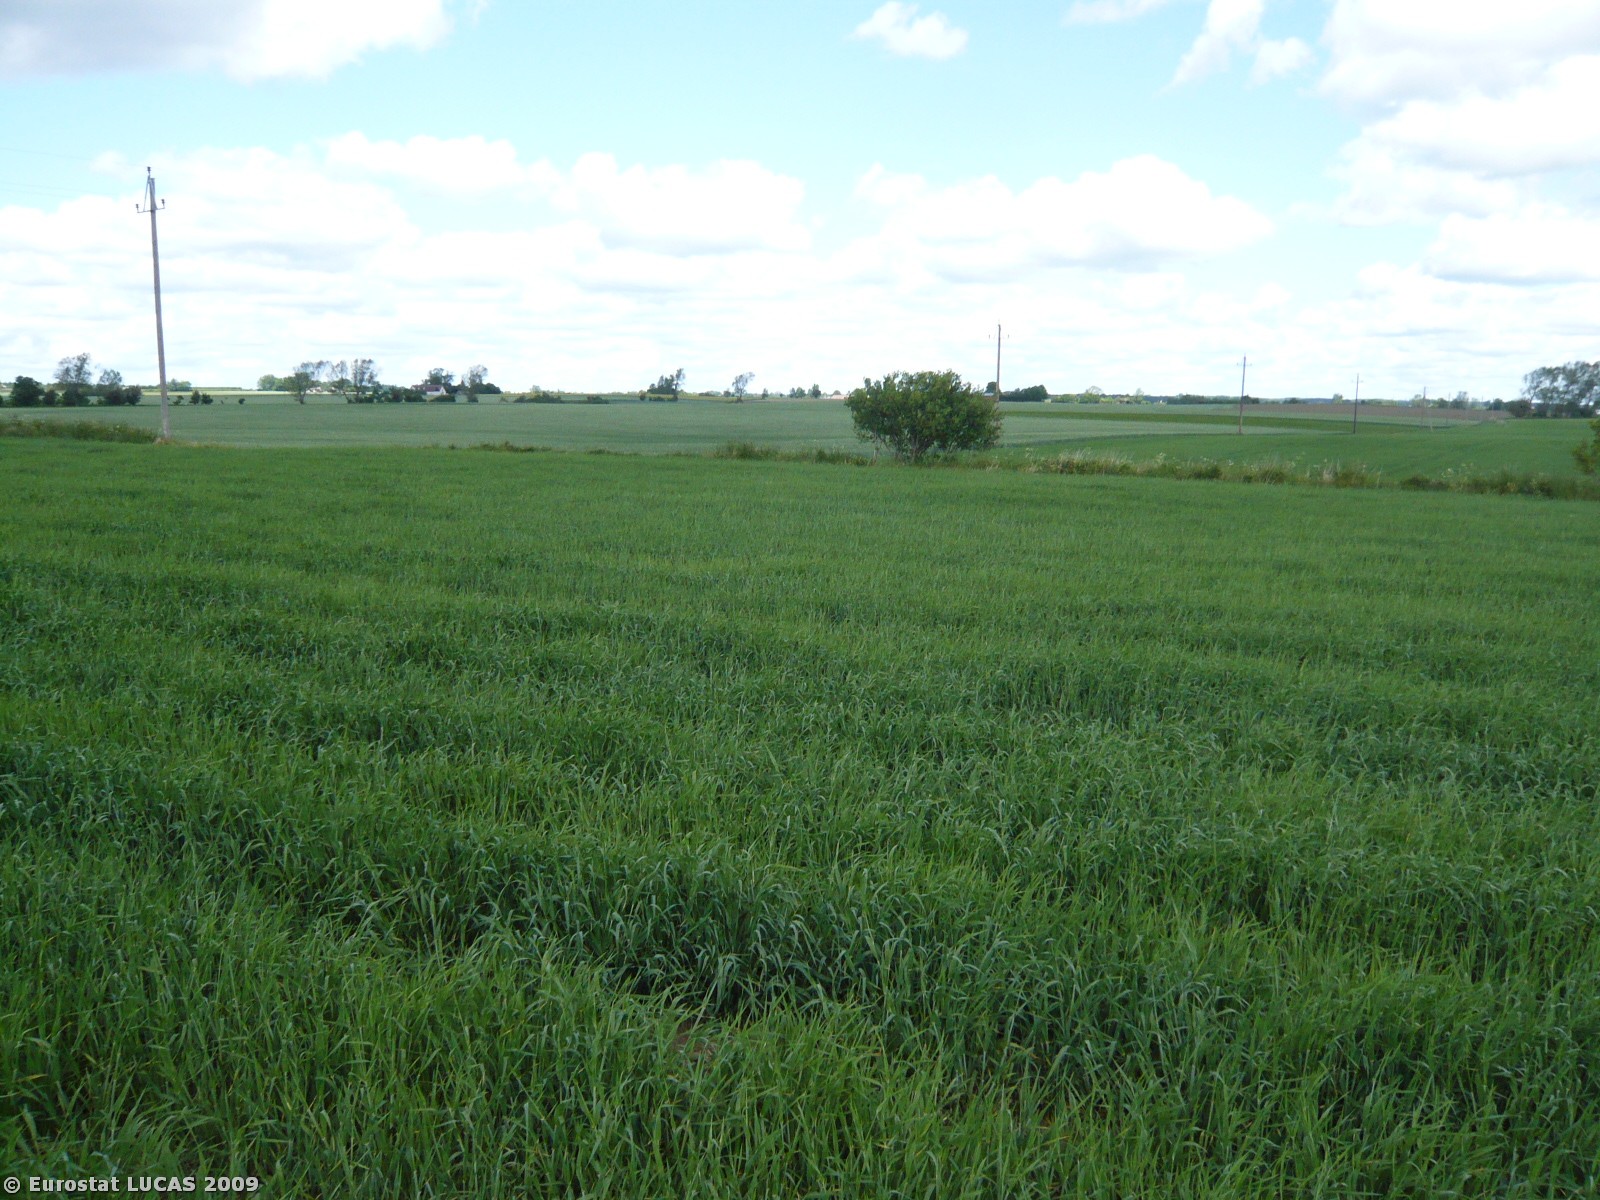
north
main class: Cropland
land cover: Barley
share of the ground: > 75 %
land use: Agriculture (excluding fallow land and kitchen gardens)
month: June
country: DK
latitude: 55.2255
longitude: 11.5552
